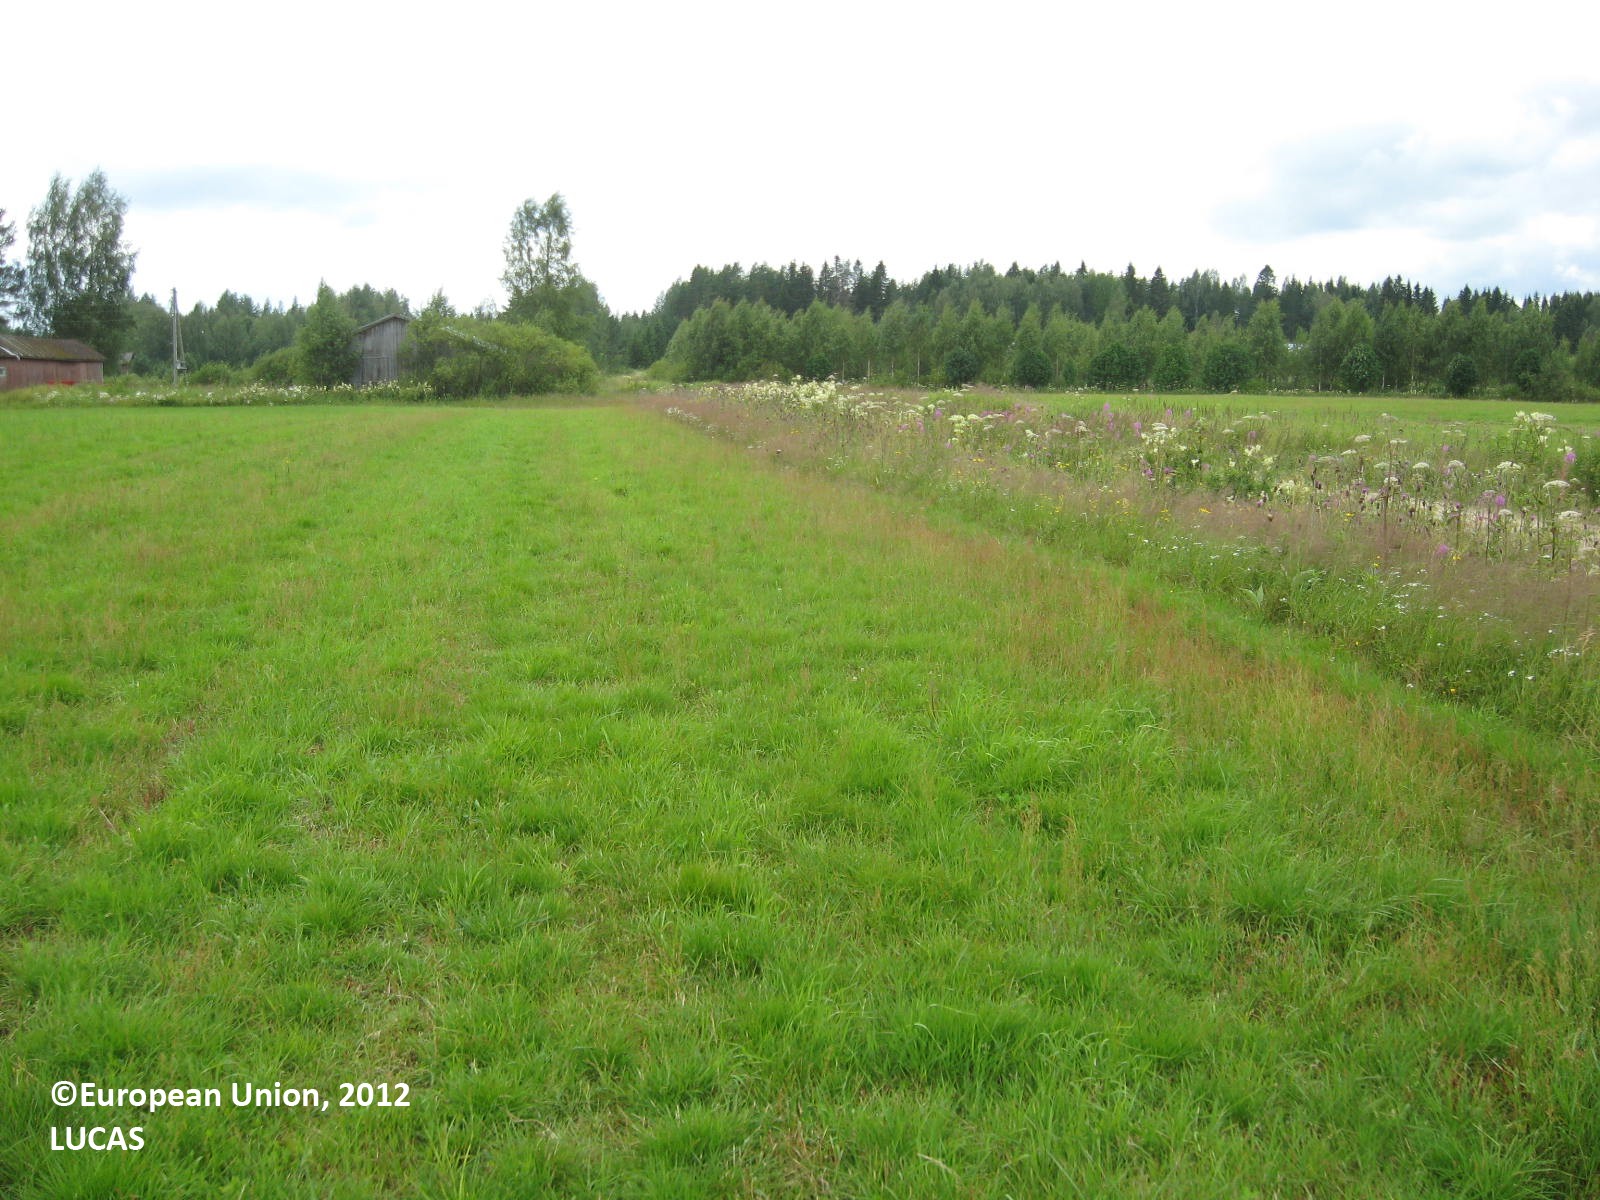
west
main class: Cropland
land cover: Temporary grasslands
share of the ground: > 75 %
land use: Agriculture (excluding fallow land and kitchen gardens)
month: July
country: FI
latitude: 62.1946
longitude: 22.7640
